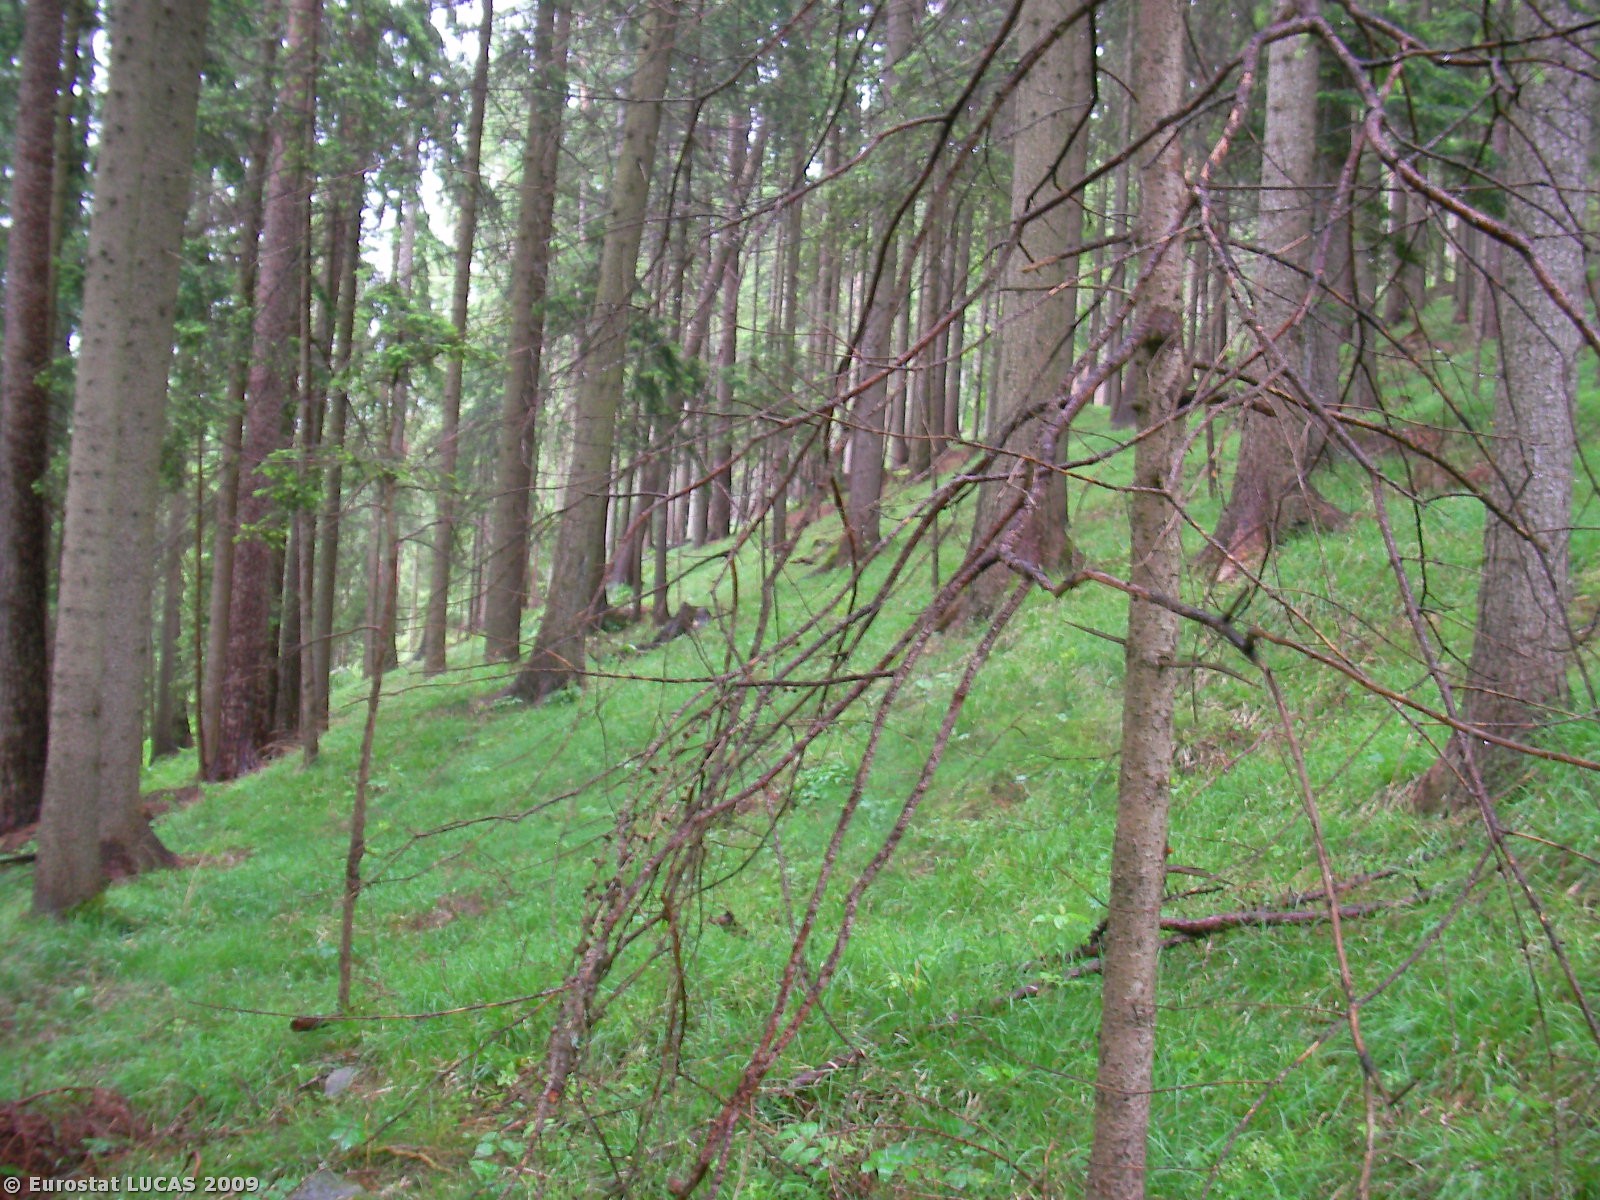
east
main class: Woodland
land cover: Coniferous woodland
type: alpine coniferous forest
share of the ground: > 75 %
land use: Forestry
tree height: > 5 m
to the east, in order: Coniferous woodland; Tracks; Coniferous woodland
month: May
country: AT
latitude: 47.2712
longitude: 15.5654
